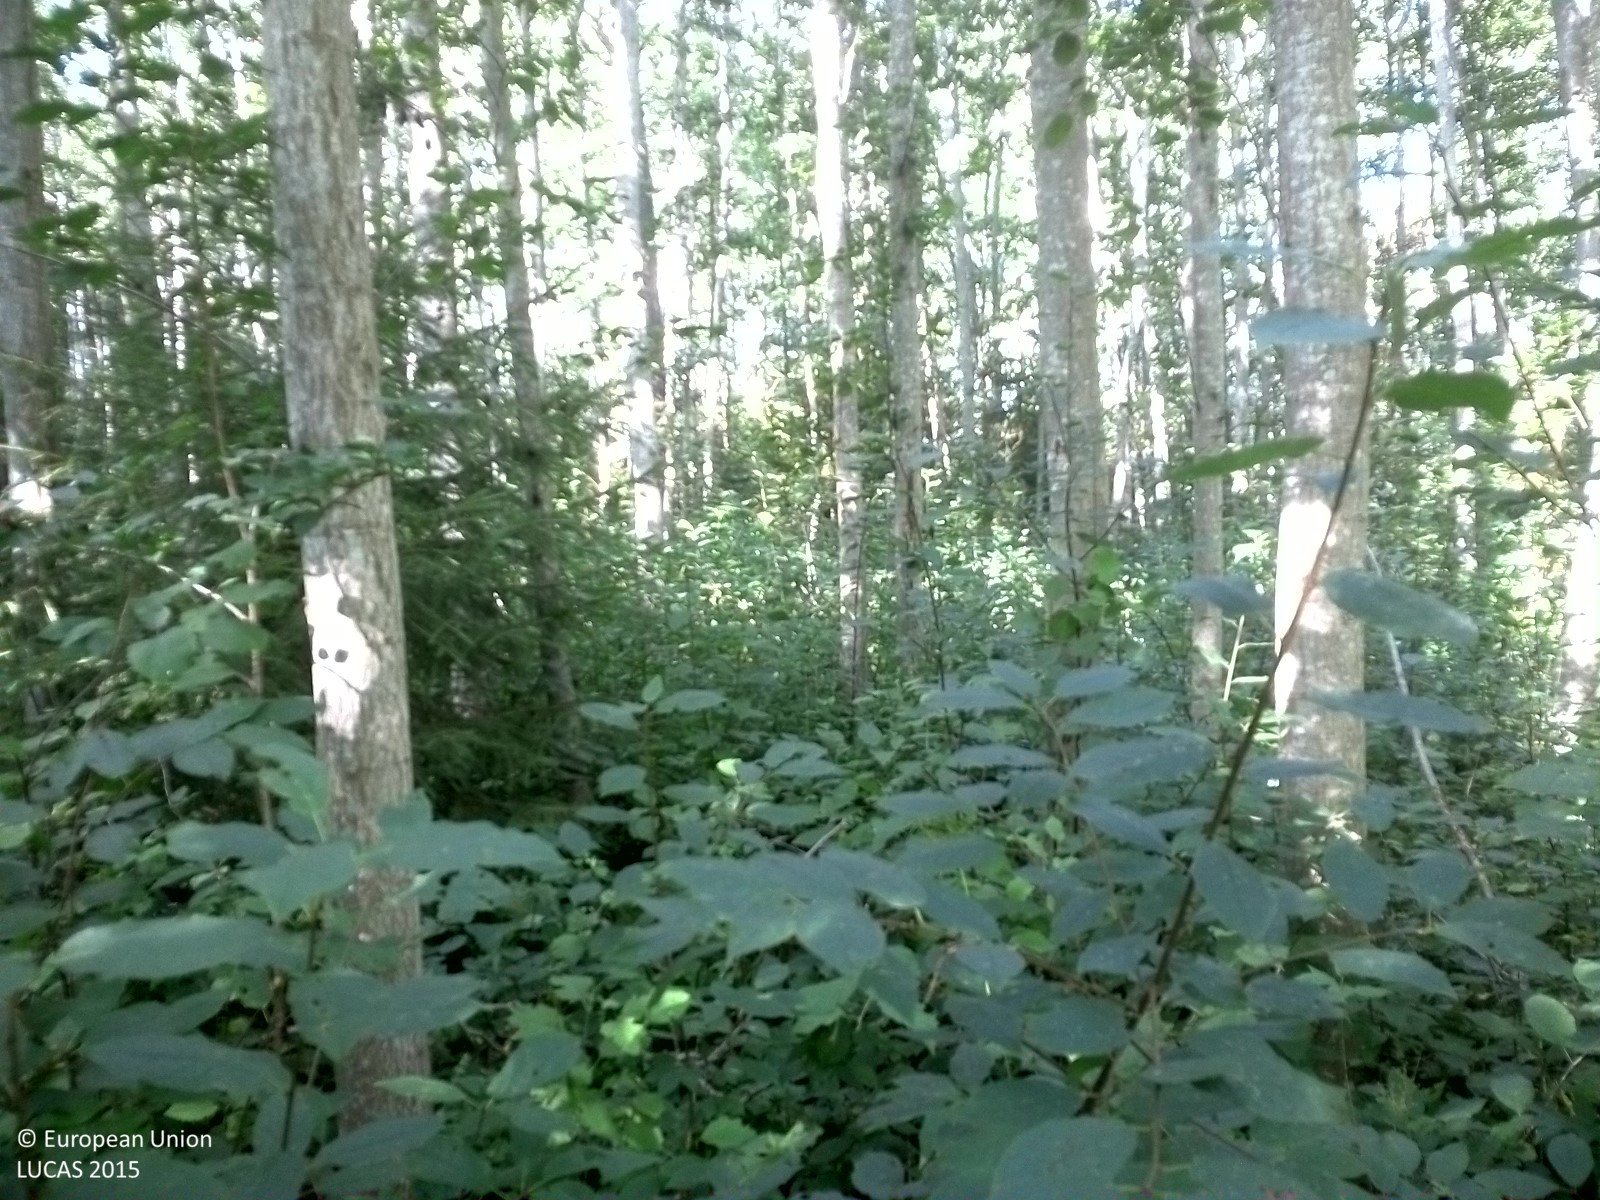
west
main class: Woodland
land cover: Broadleaved woodland
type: hemiboreal forest and nemoral coniferous forest and mixed broadleaved-coniferous forest
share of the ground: 50 - 75 %
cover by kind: broadleaved forest trees 65 %, shrubs 10 %, herbaceous plants 10 %, coniferous forest trees 5 %, lichens and mosses 5 %, unconsolidated bare surface 5 %
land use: Forestry
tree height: > 5 m
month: August
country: SE
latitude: 59.1324
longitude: 15.5667
